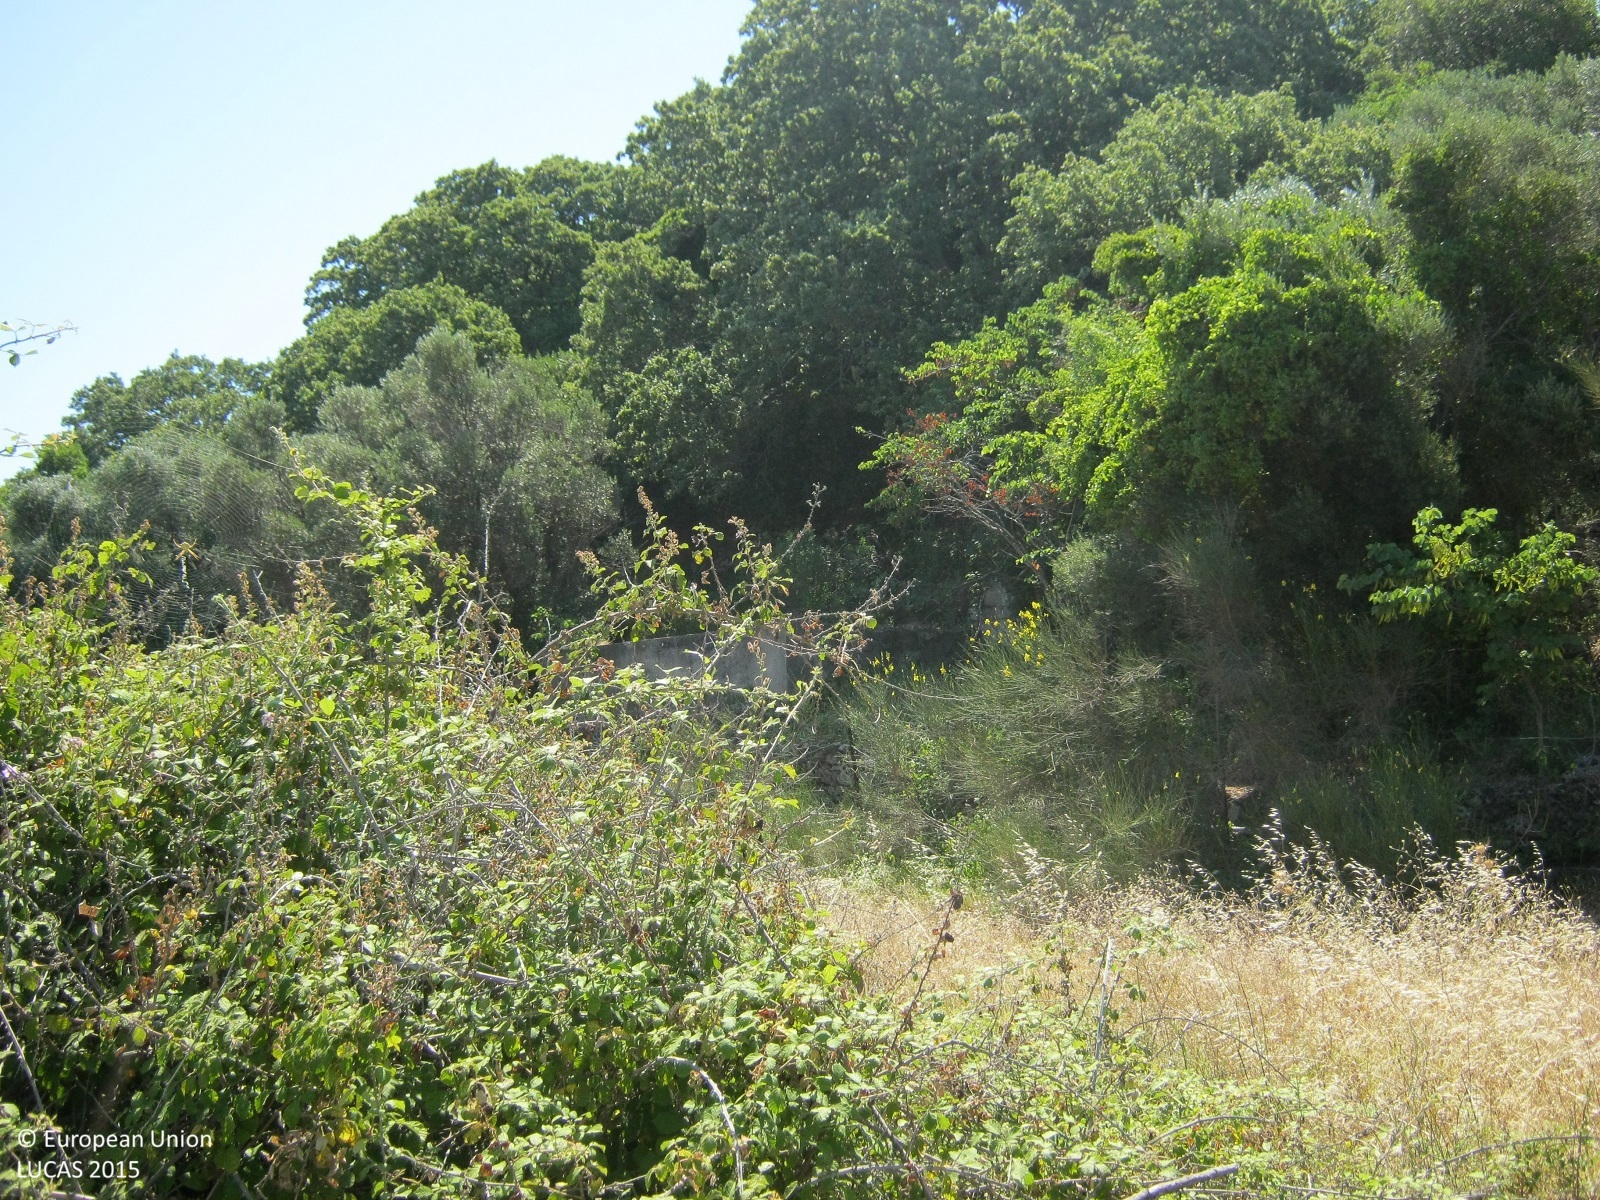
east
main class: Shrubland
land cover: Shrubland without tree cover
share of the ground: > 75 %
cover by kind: shrubs 90 %, herbaceous plants 10 %
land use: Semi-natural and natural areas not in use
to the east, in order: Shrubland without tree cover; Fences; Pine dominated coniferous woodland; Olive groves; Pine dominated coniferous woodland
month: June
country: GR
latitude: 36.4034
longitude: 28.0959
